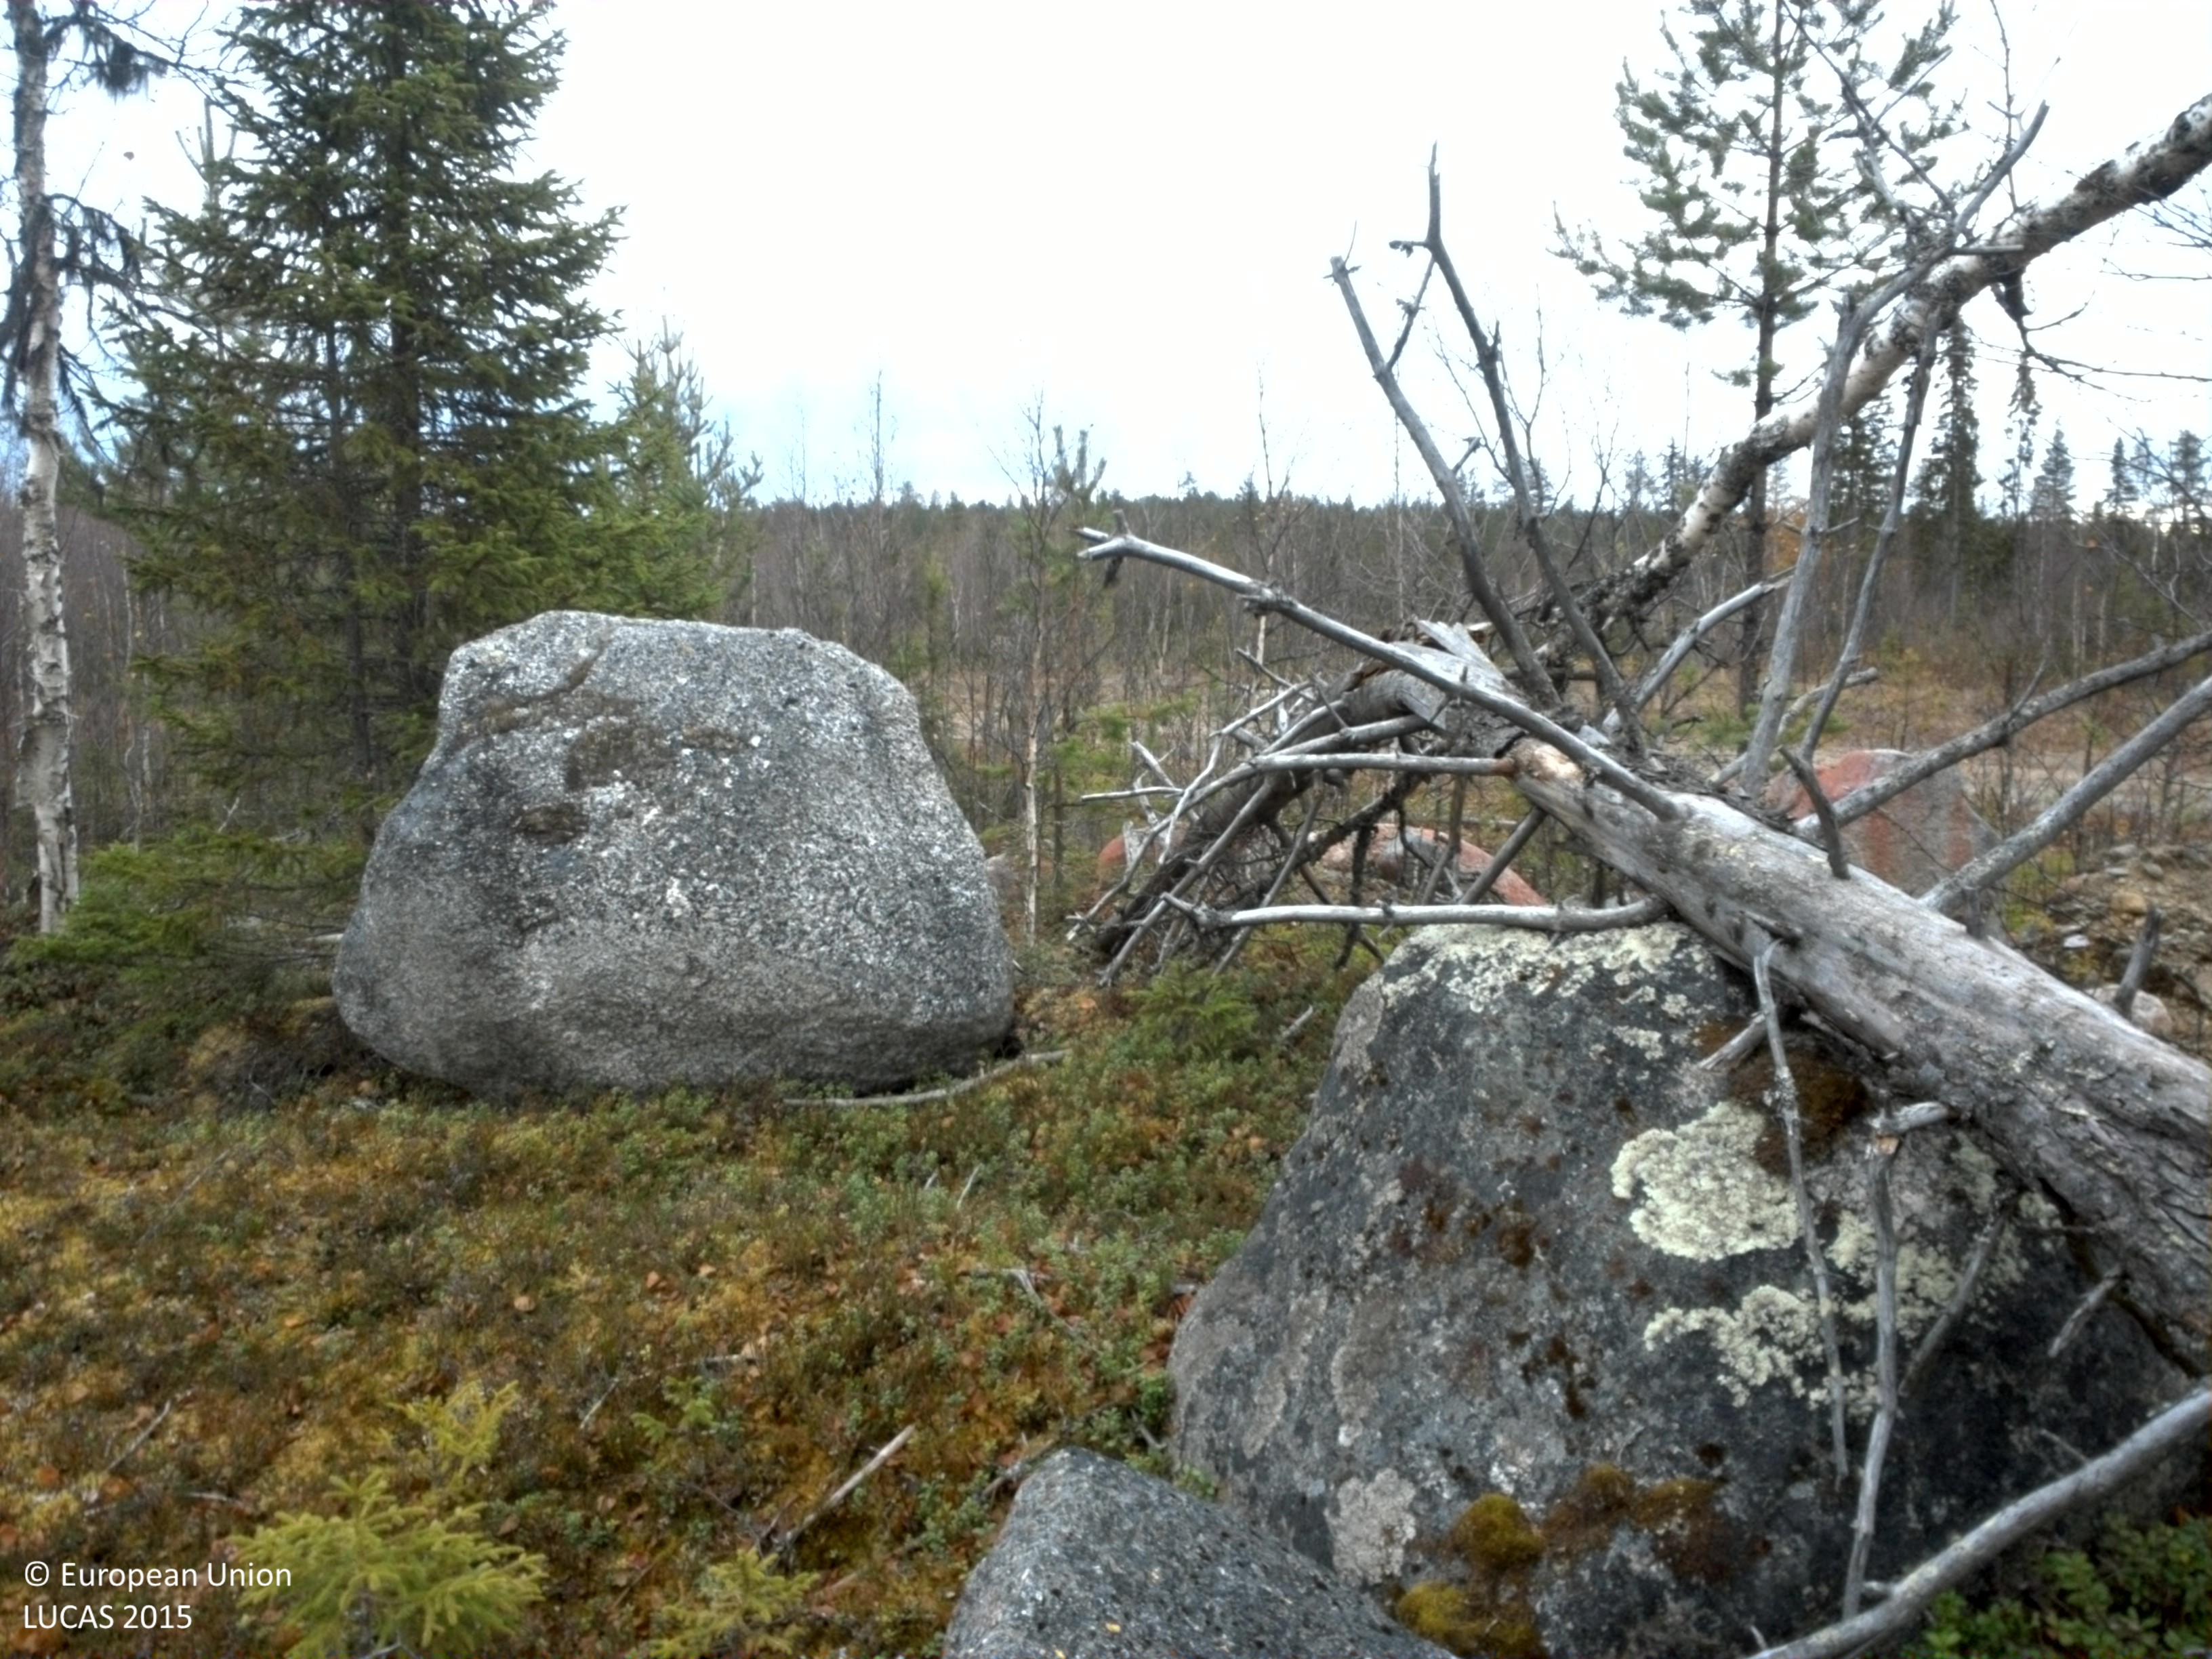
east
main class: Woodland
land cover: Other mixed woodland
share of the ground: 25 - 50 %
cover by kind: shrubs 30 %, coniferous forest trees 20 %, broadleaved forest trees 20 %, lichens and mosses 20 %, consolidated bare surface 5 %, unconsolidated bare surface 5 %
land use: Forestry
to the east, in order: Other mixed woodland; Spruce dominated mixed woodland; Paved roads, cycling and walking lanes; Spontaneously vegetated surfaces; Other mixed woodland; Pine dominated mixed woodland; Spruce dominated mixed woodland; Grassland with sparse tree/shrub cover; Other coniferous woodland; Pine dominated coniferous woodland; Other mixed woodland
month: October
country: SE
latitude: 64.5701
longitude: 17.0007
